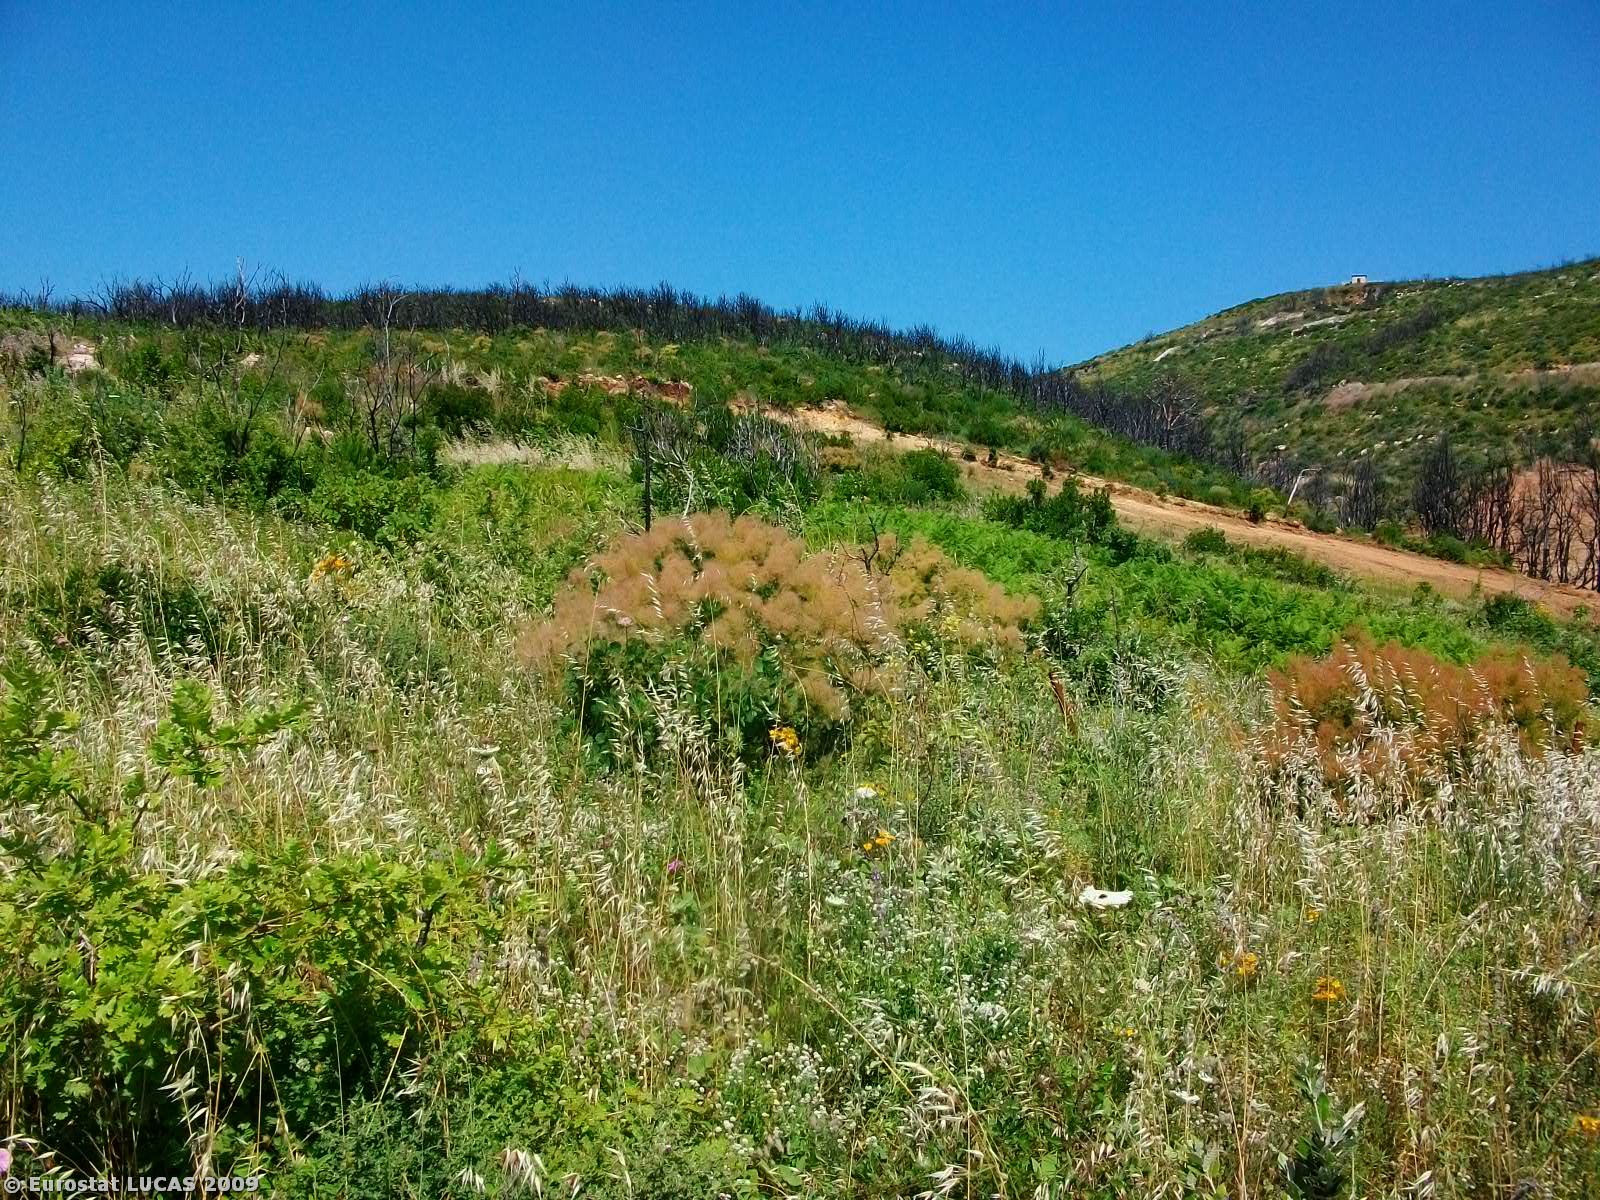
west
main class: Grassland
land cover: Grassland with sparse tree/shrub cover
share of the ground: > 75 %
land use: Unused
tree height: < 5 m
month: June
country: GR
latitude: 39.2884
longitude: 23.2689
